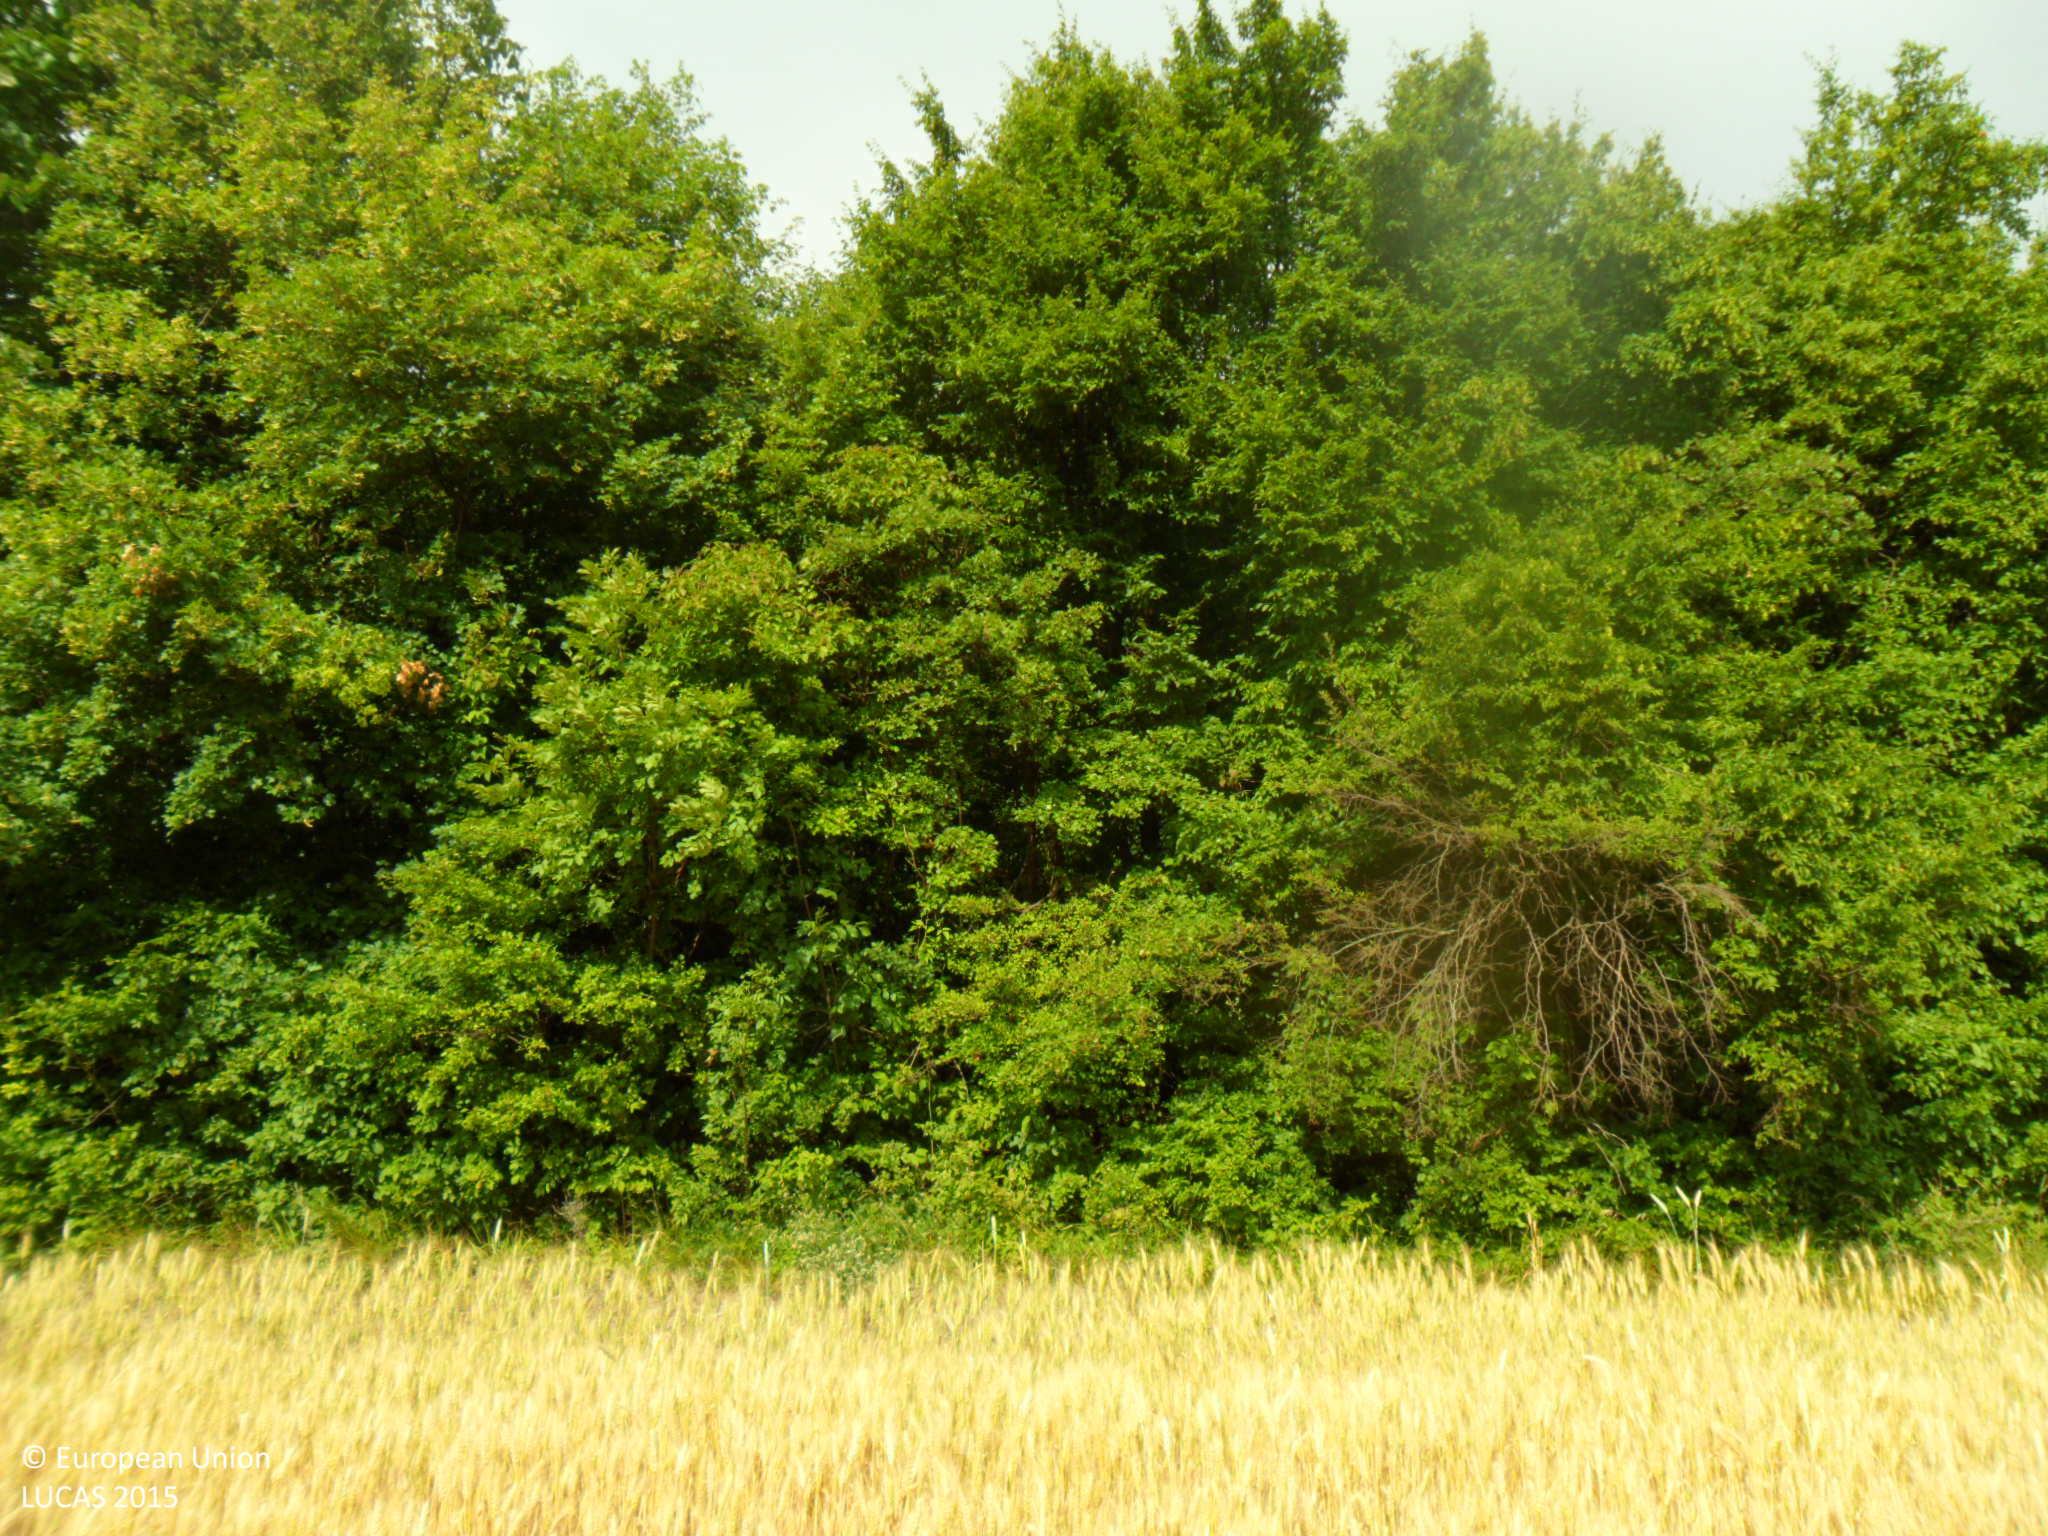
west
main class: Cropland
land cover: Common wheat
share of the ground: > 75 %
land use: Agriculture (excluding fallow land and kitchen gardens)
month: June
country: BG
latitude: 43.4852
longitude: 27.1216
